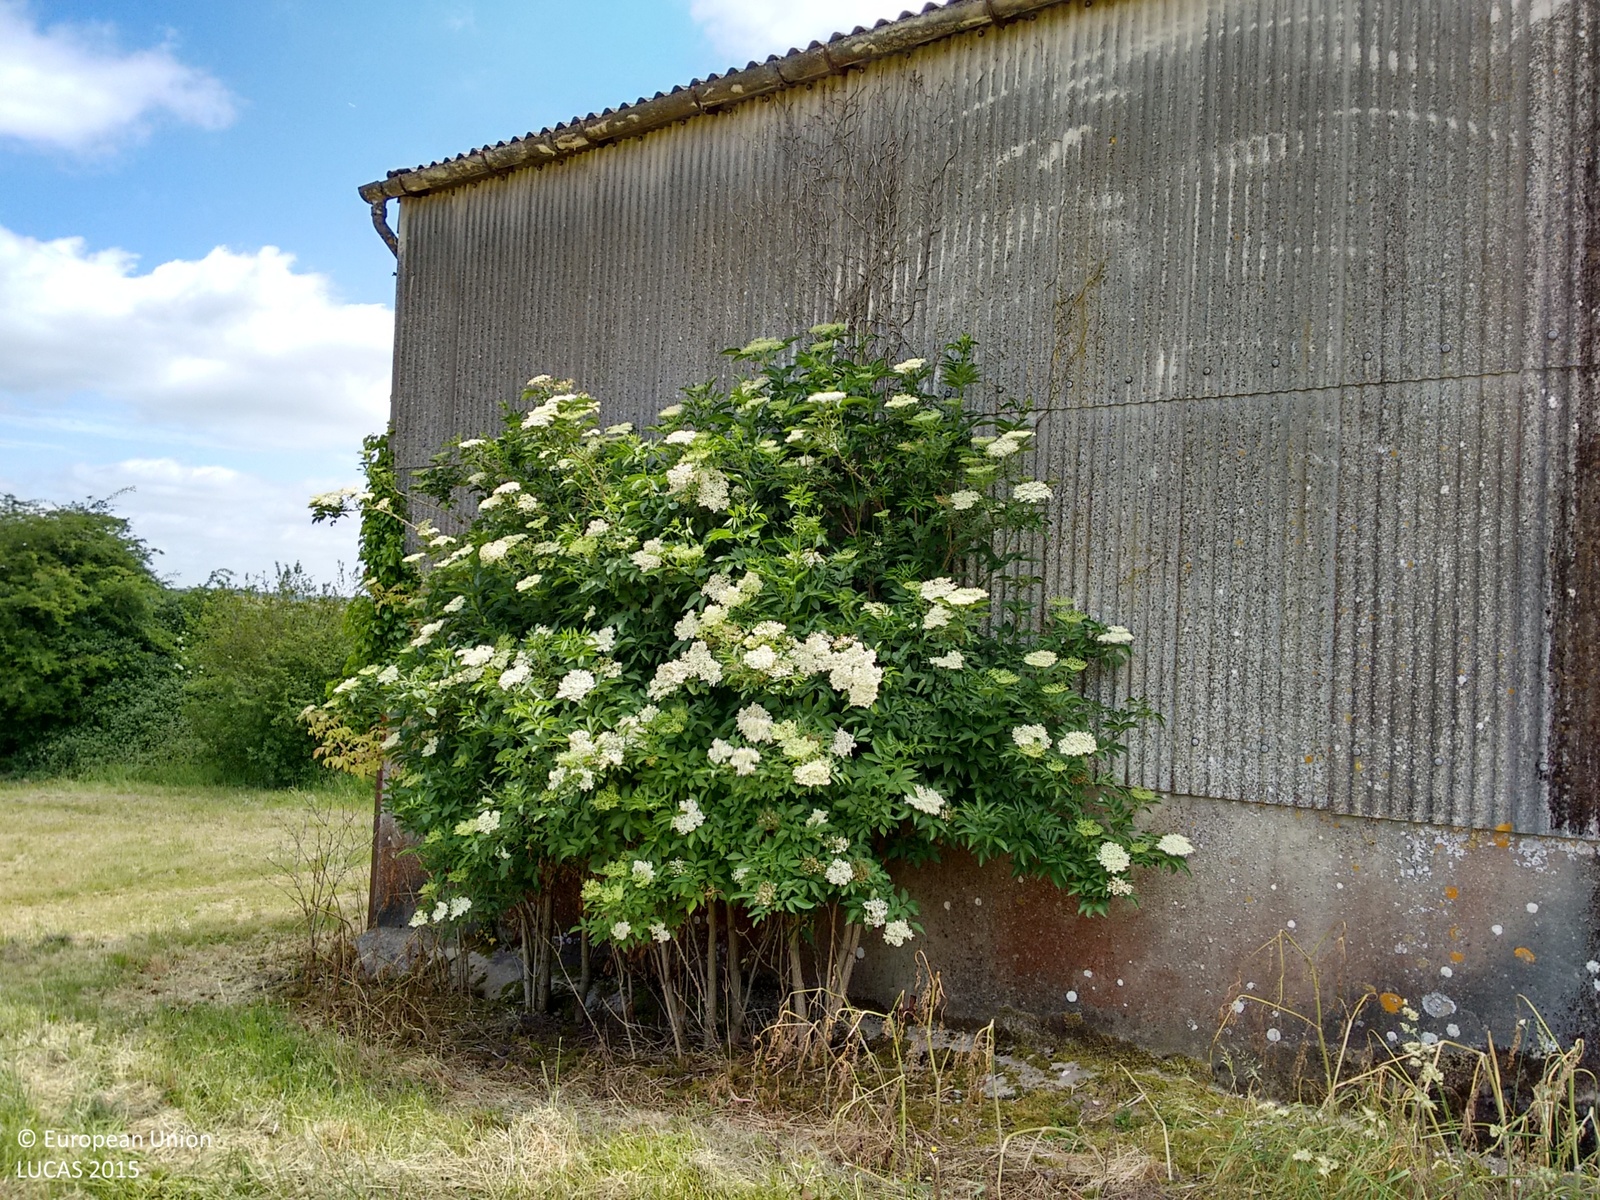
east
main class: Grassland
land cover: Grassland without tree/shrub cover
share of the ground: > 75 %
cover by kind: herbaceous plants 100 %
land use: Agriculture (excluding fallow land and kitchen gardens)
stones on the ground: 10 - 25 %
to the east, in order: Grassland without tree/shrub cover; Artificial constructions in urban areas; Grassland without tree/shrub cover; Broadleaved woodland; Paved roads, cycling and walking lanes; Electric lines; Managed hedges; Grassland without tree/shrub cover; Managed hedges; Grassland without tree/shrub cover; Managed hedges; Grassland without tree/shrub cover; Fences; Lines of trees; Grassland without tree/shrub cover
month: June
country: GB
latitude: 51.4894
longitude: -1.5009
